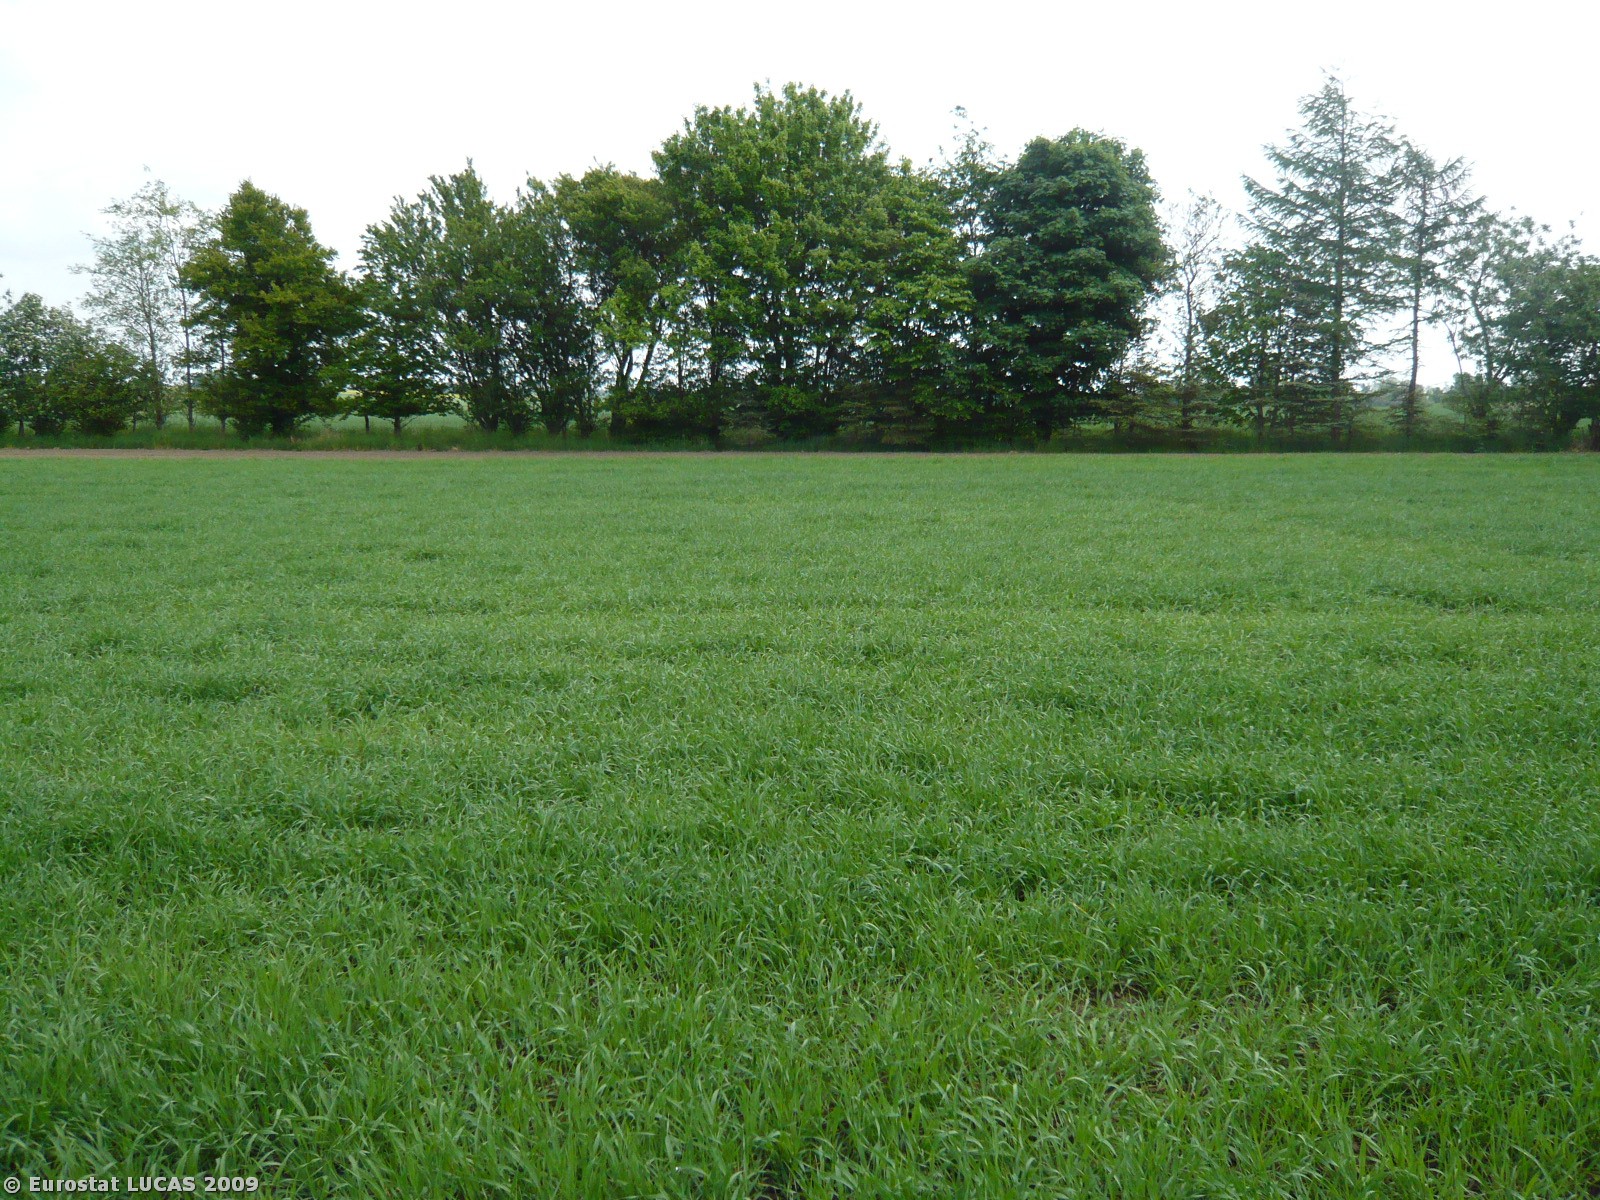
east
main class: Cropland
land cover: Barley
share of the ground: > 75 %
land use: Agriculture (excluding fallow land and kitchen gardens)
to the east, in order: Barley; Bare land; Broadleaved woodland; Common wheat
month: May
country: DK
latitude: 55.3465
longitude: 11.9066
